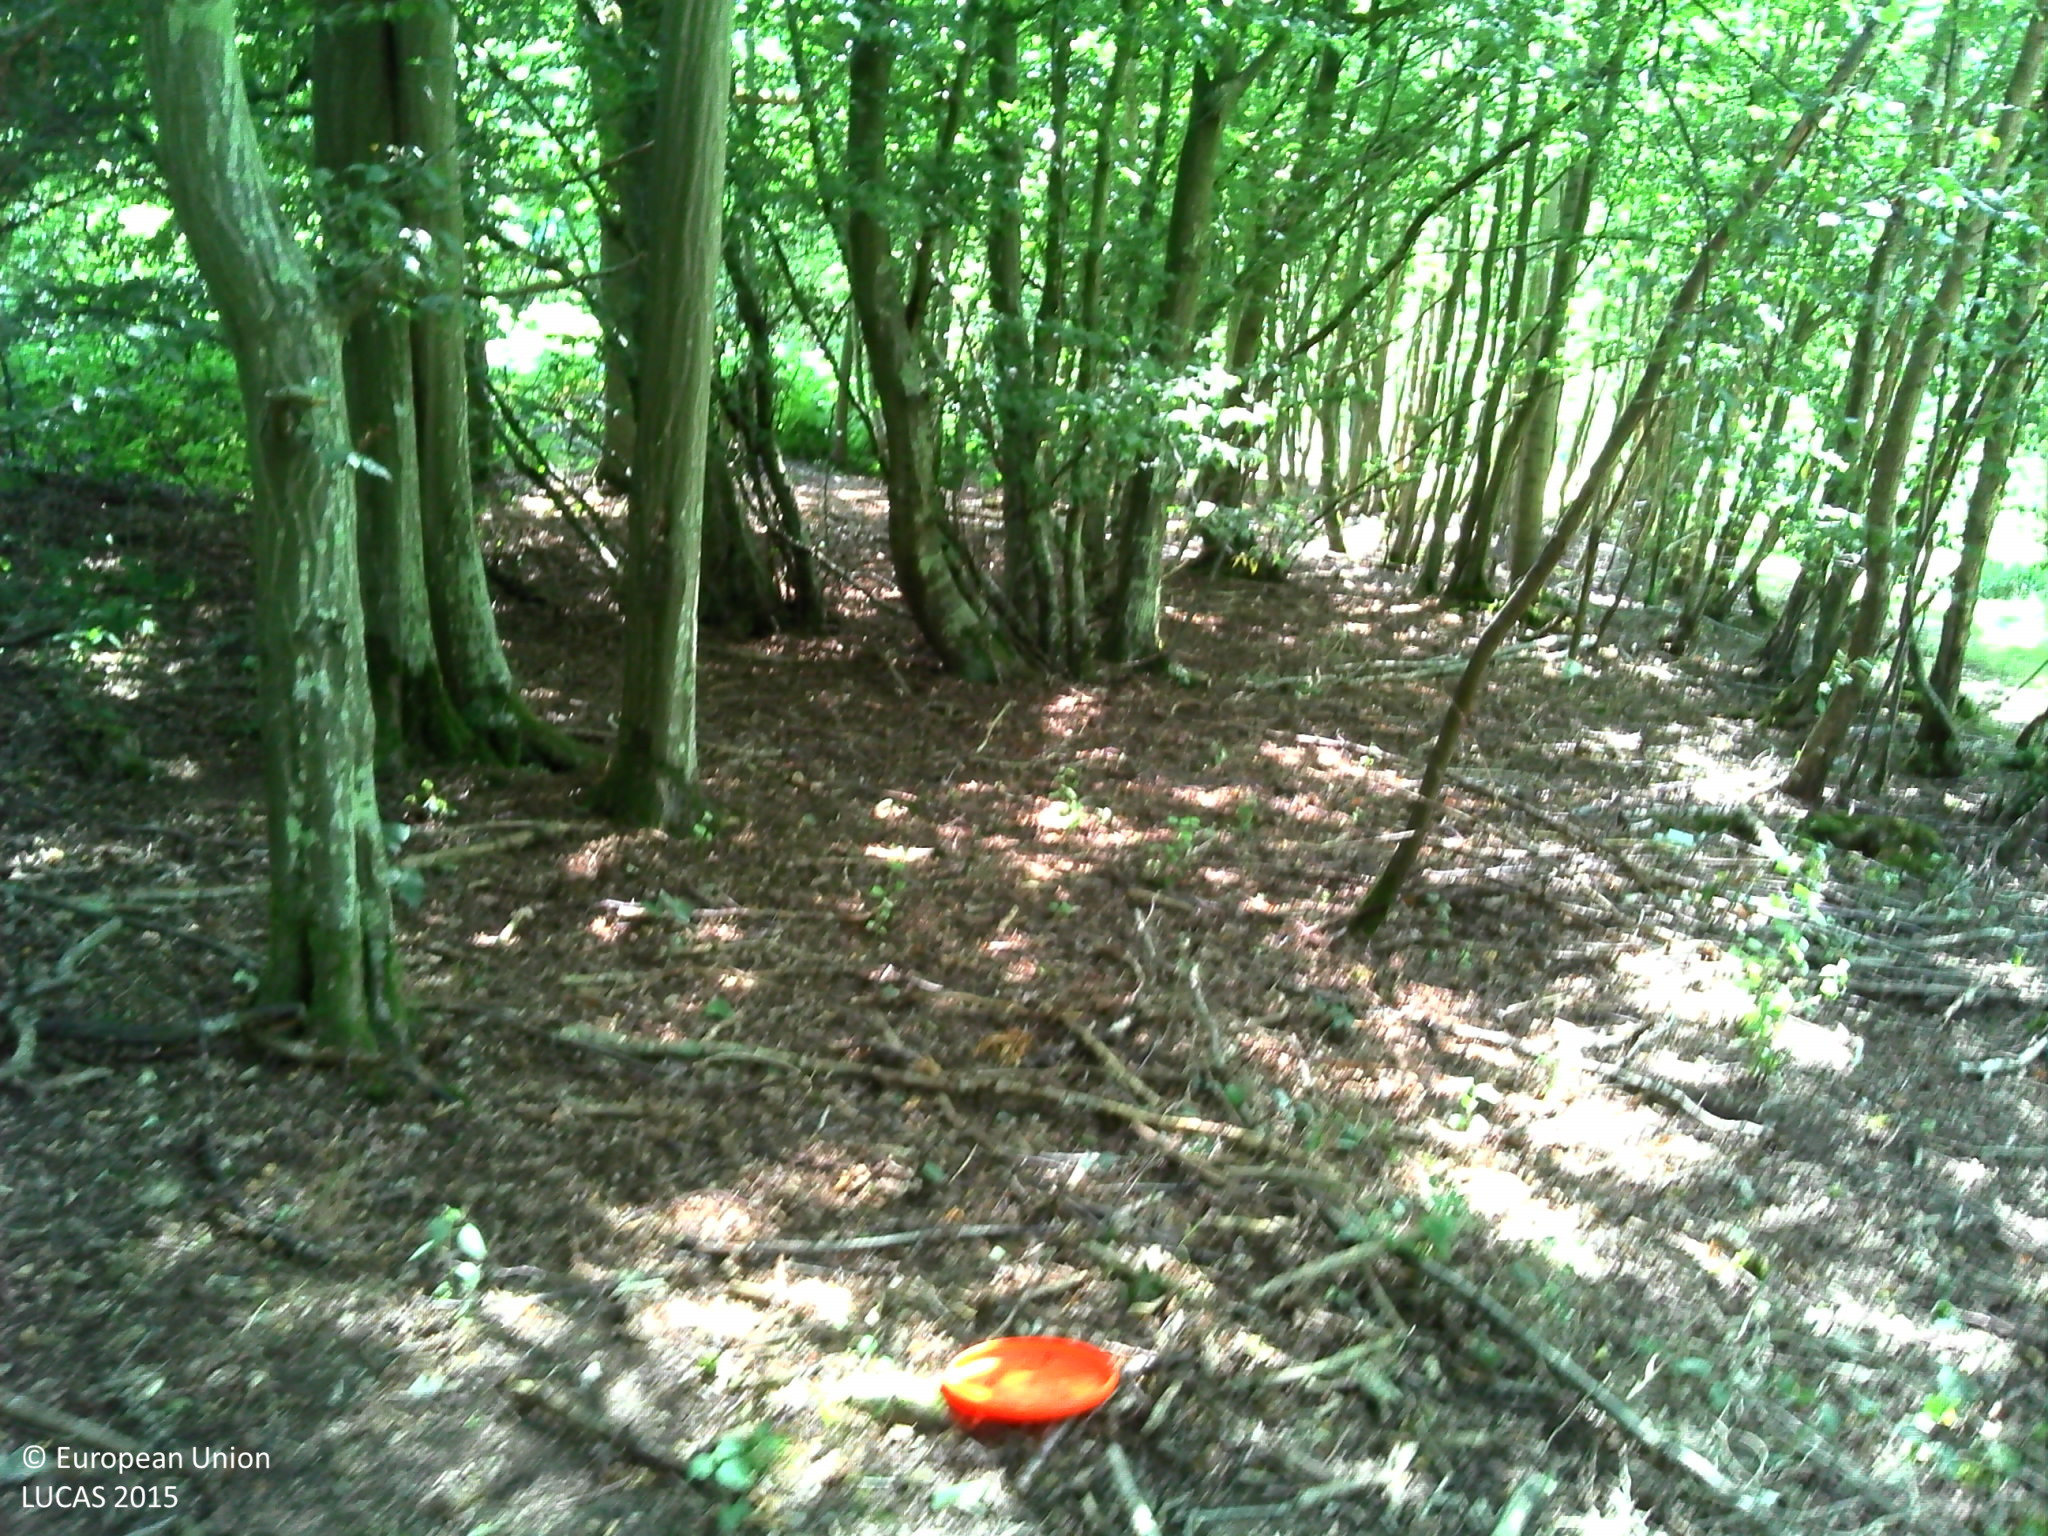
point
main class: Woodland
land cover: Broadleaved woodland
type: mesophytic deciduous forest
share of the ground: > 75 %
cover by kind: broadleaved forest trees 90 %, lichens and mosses 5 %, unconsolidated bare surface 5 %
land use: Forestry
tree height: > 5 m
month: August
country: FR
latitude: 50.8615
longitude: 2.0139
